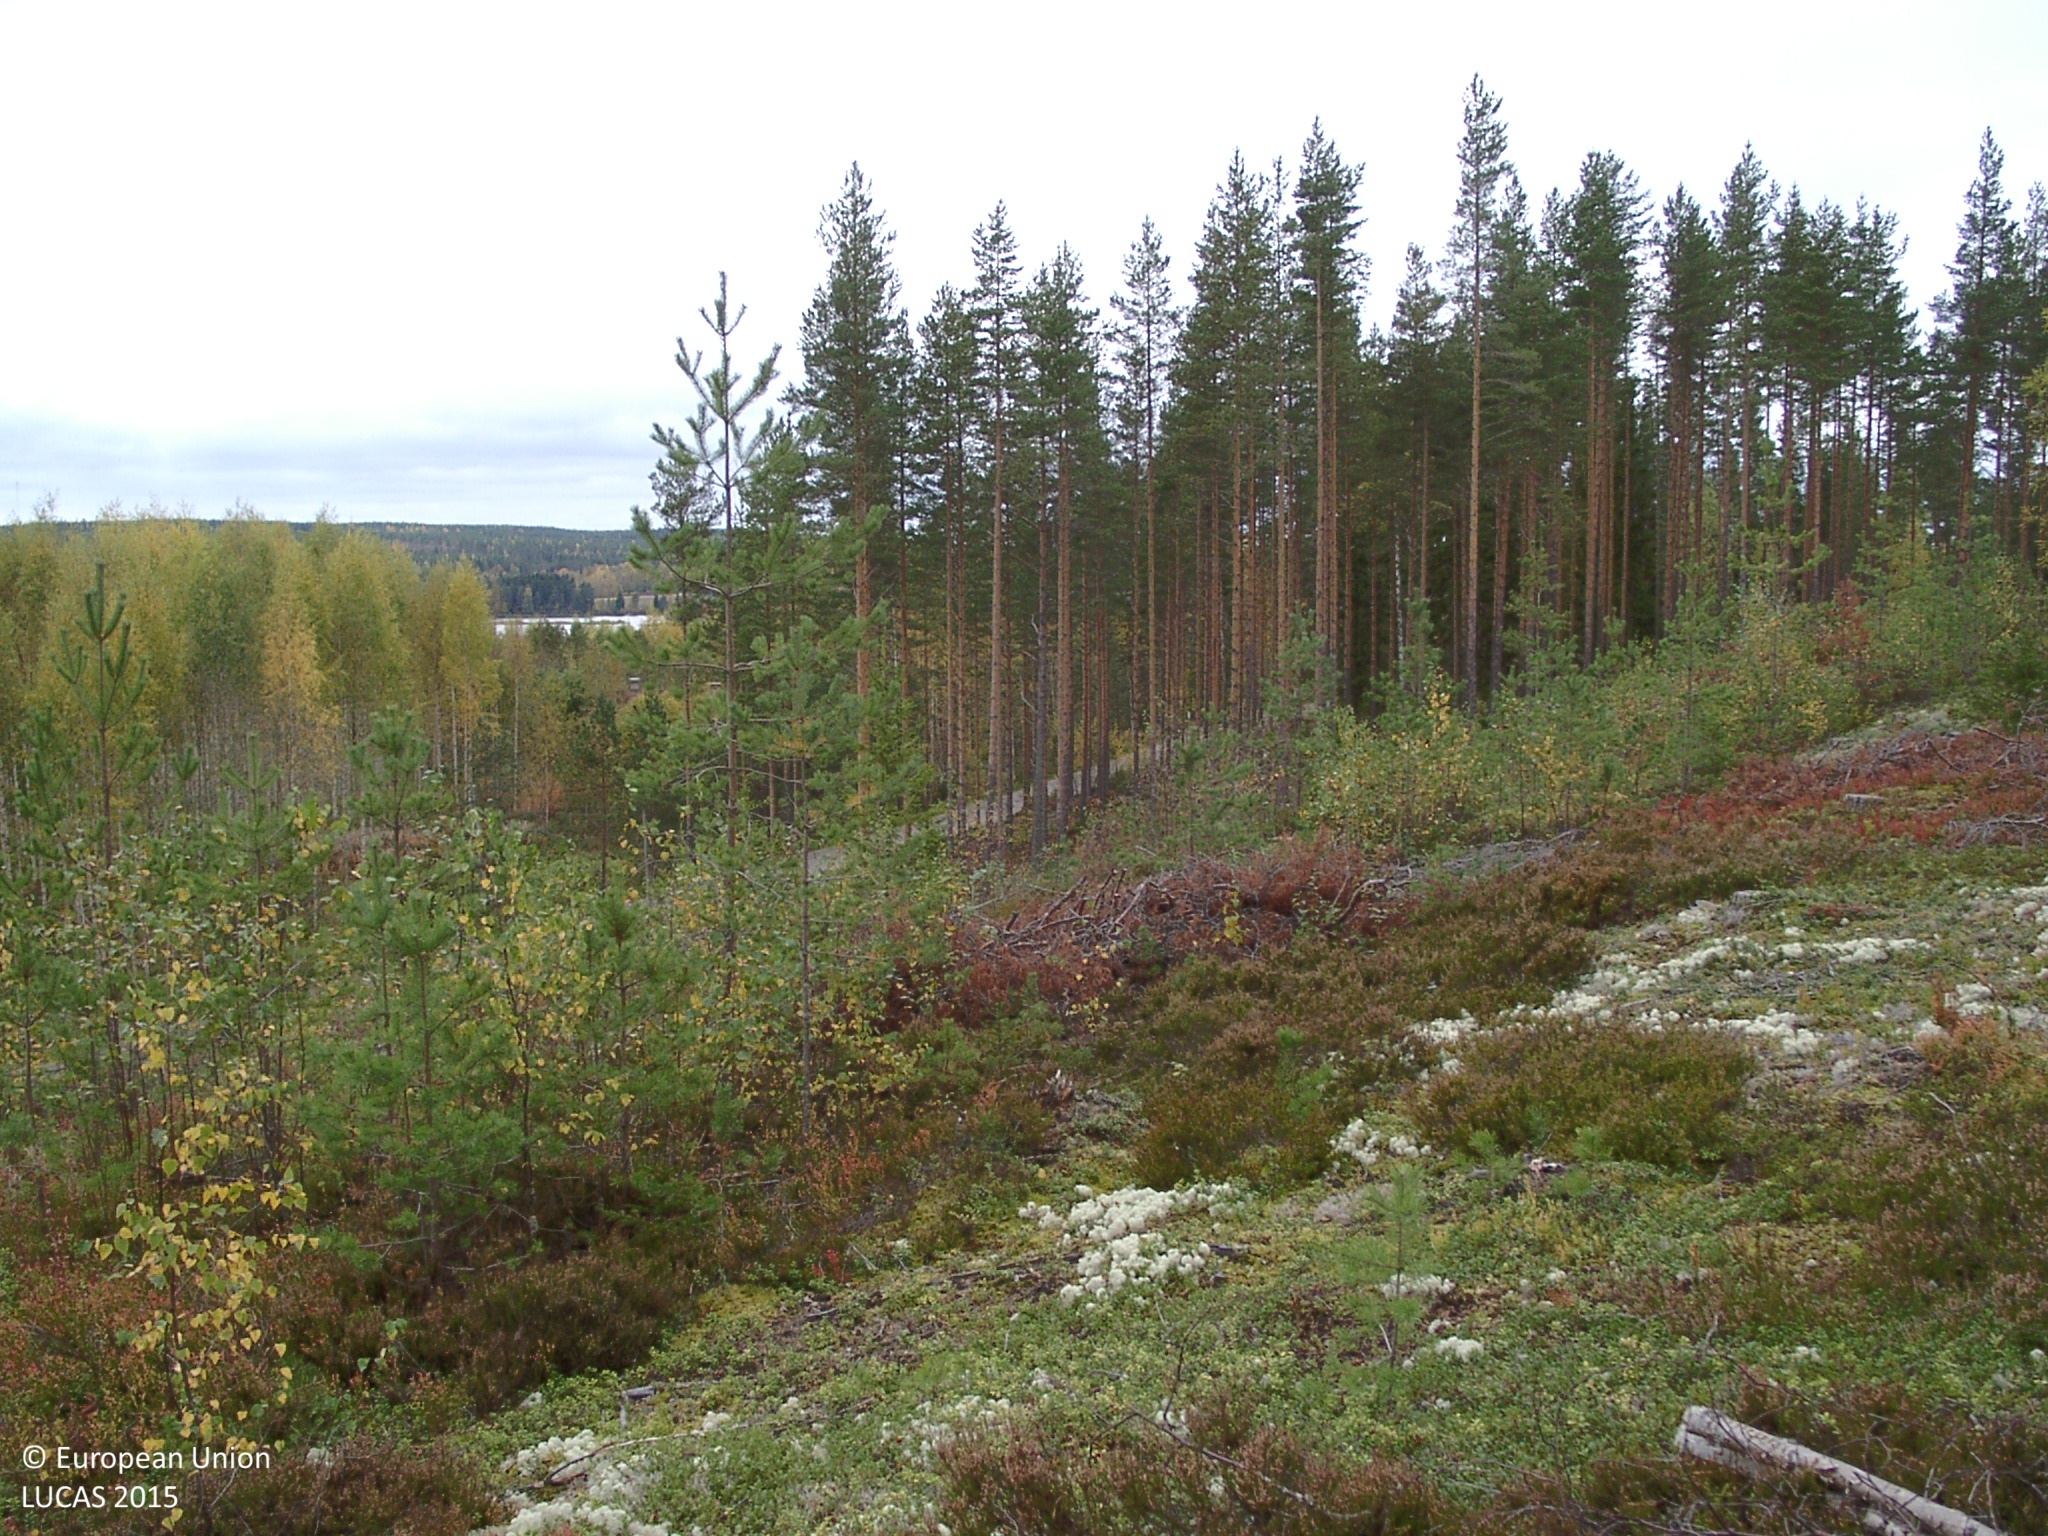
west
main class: Shrubland
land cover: Shrubland with sparse tree cover
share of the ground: 50 - 75 %
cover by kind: shrubs 60 %, lichens and mosses 30 %, coniferous forest trees 5 %
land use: Forestry
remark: Clear cut
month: September
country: FI
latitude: 62.6019
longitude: 25.4393
